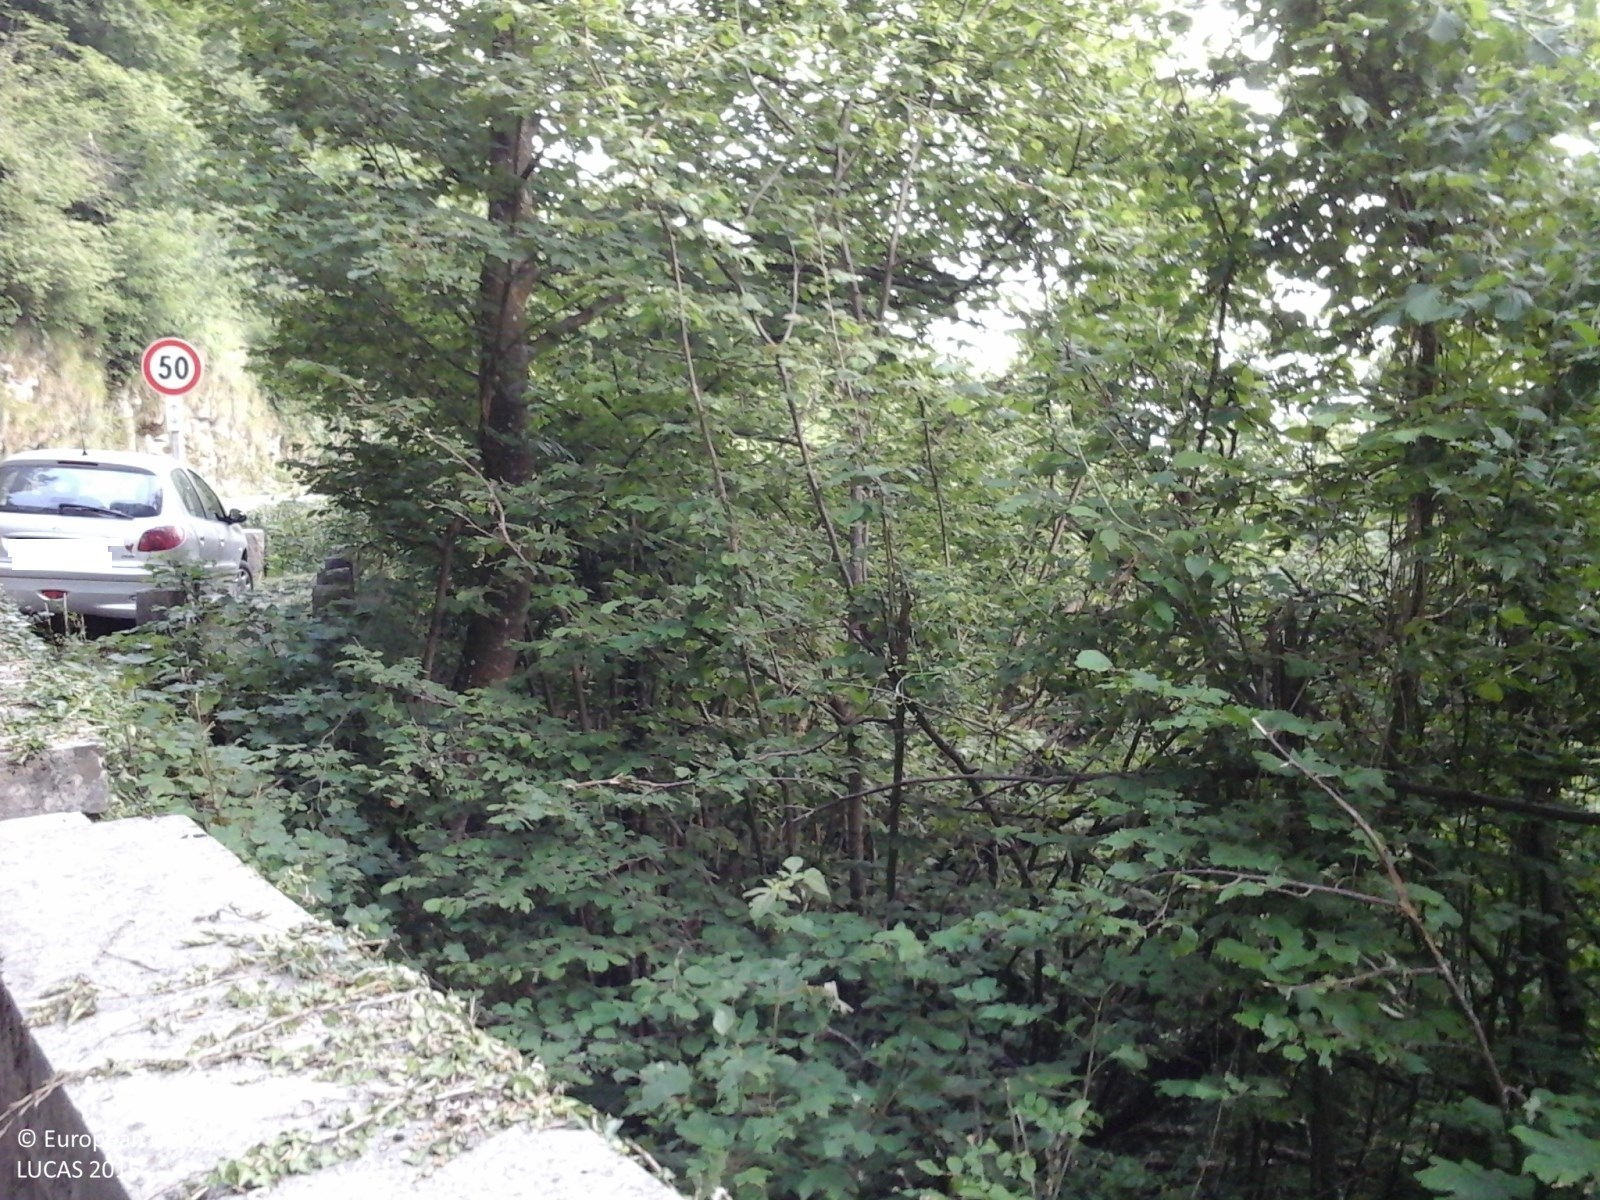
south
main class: Woodland
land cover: Broadleaved woodland
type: thermophilous deciduous forest
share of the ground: > 75 %
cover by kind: broadleaved forest trees 100 %
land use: Semi-natural and natural areas not in use
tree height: > 5 m
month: June
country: IT
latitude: 45.8326
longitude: 11.7354
